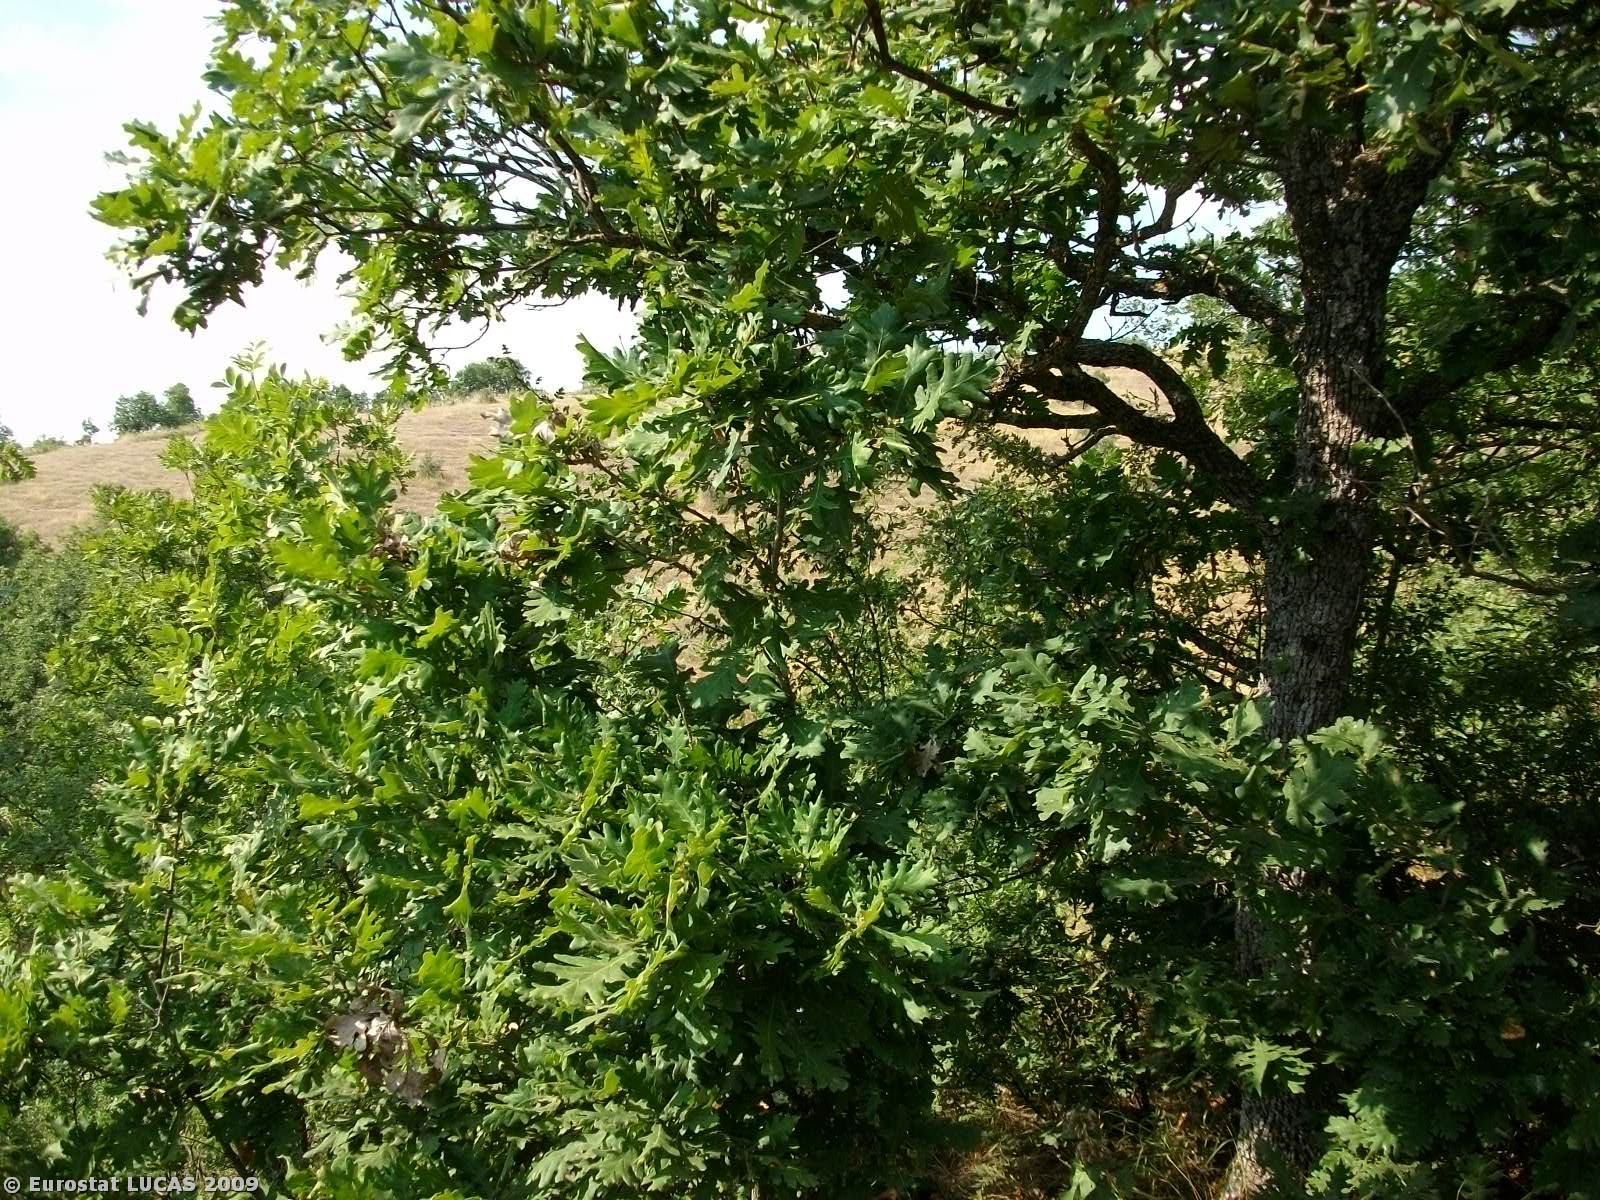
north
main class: Woodland
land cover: Broadleaved woodland
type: thermophilous deciduous forest
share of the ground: 50 - 75 %
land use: Forestry
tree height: > 5 m
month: July
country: GR
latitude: 39.7993
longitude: 21.7233
